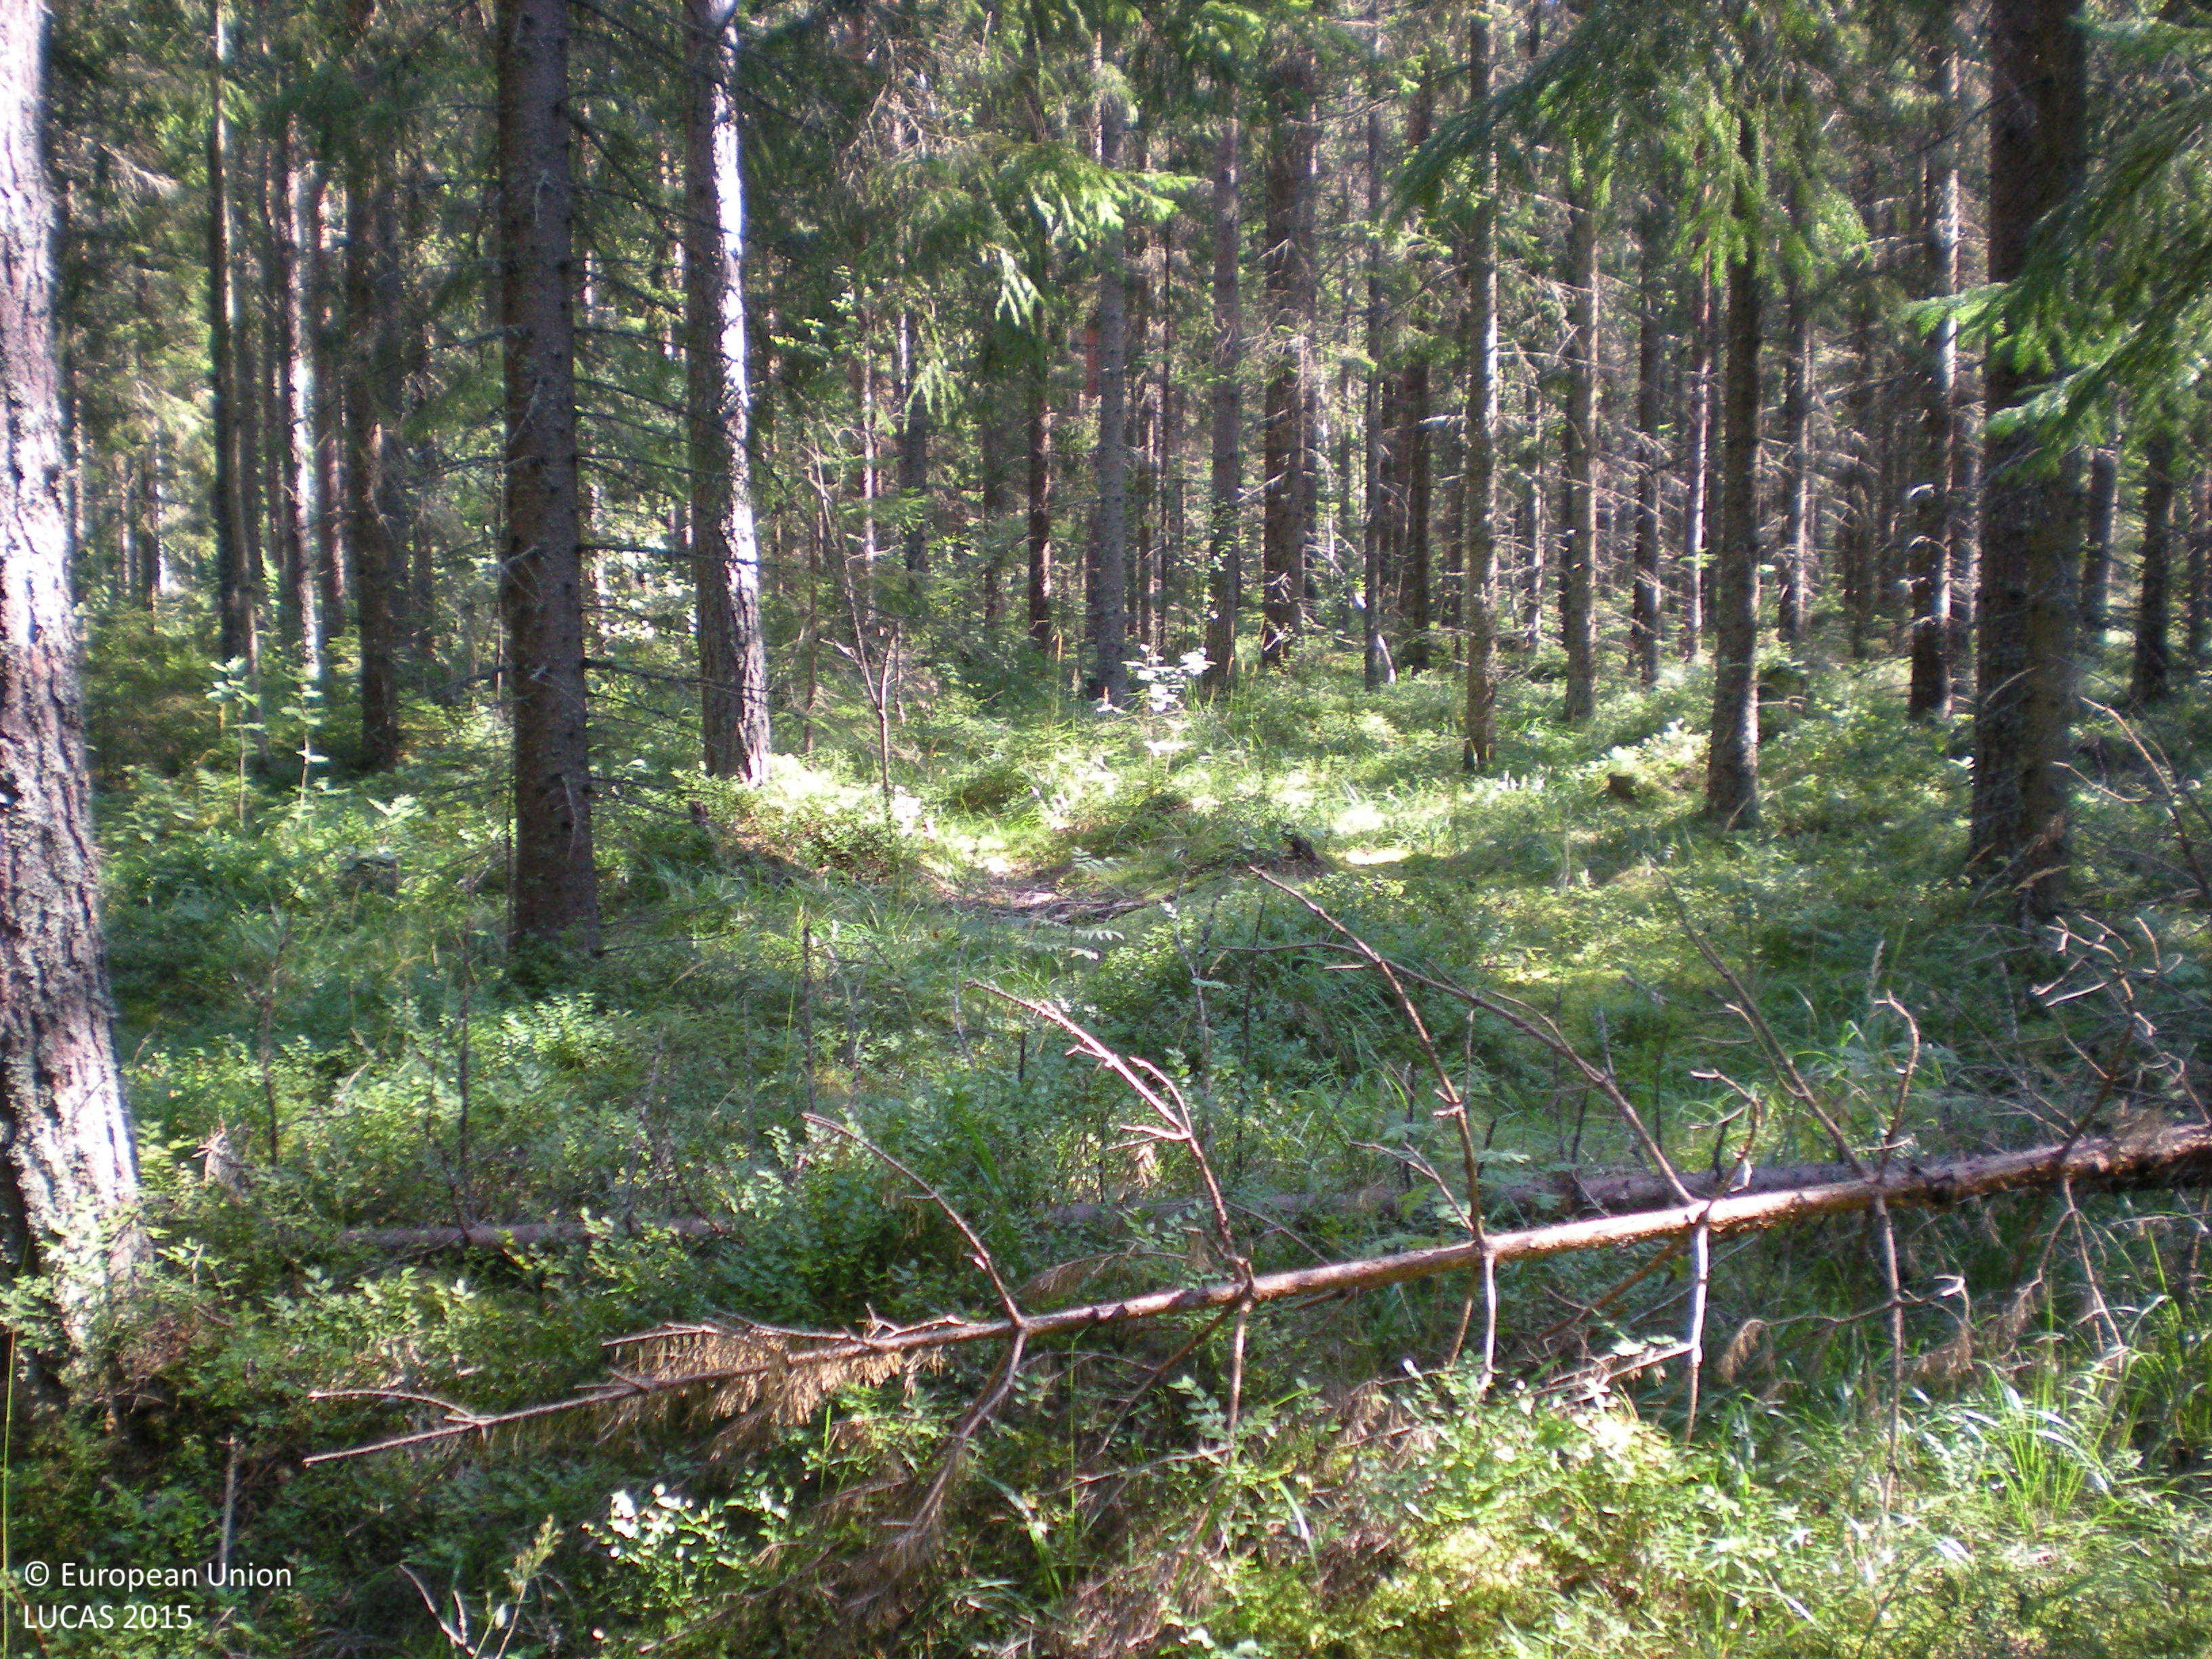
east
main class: Woodland
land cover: Spruce dominated coniferous woodland
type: boreal forest
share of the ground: 50 - 75 %
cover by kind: coniferous forest trees 70 %, shrubs 20 %, herbaceous plants 5 %, lichens and mosses 5 %
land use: Forestry
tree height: > 5 m
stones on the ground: 10 - 25 %
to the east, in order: Spruce dominated coniferous woodland; Ditches and canals; Other coniferous woodland; Pine dominated coniferous woodland; Spruce dominated coniferous woodland
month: August
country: SE
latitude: 60.4486
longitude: 17.2064
